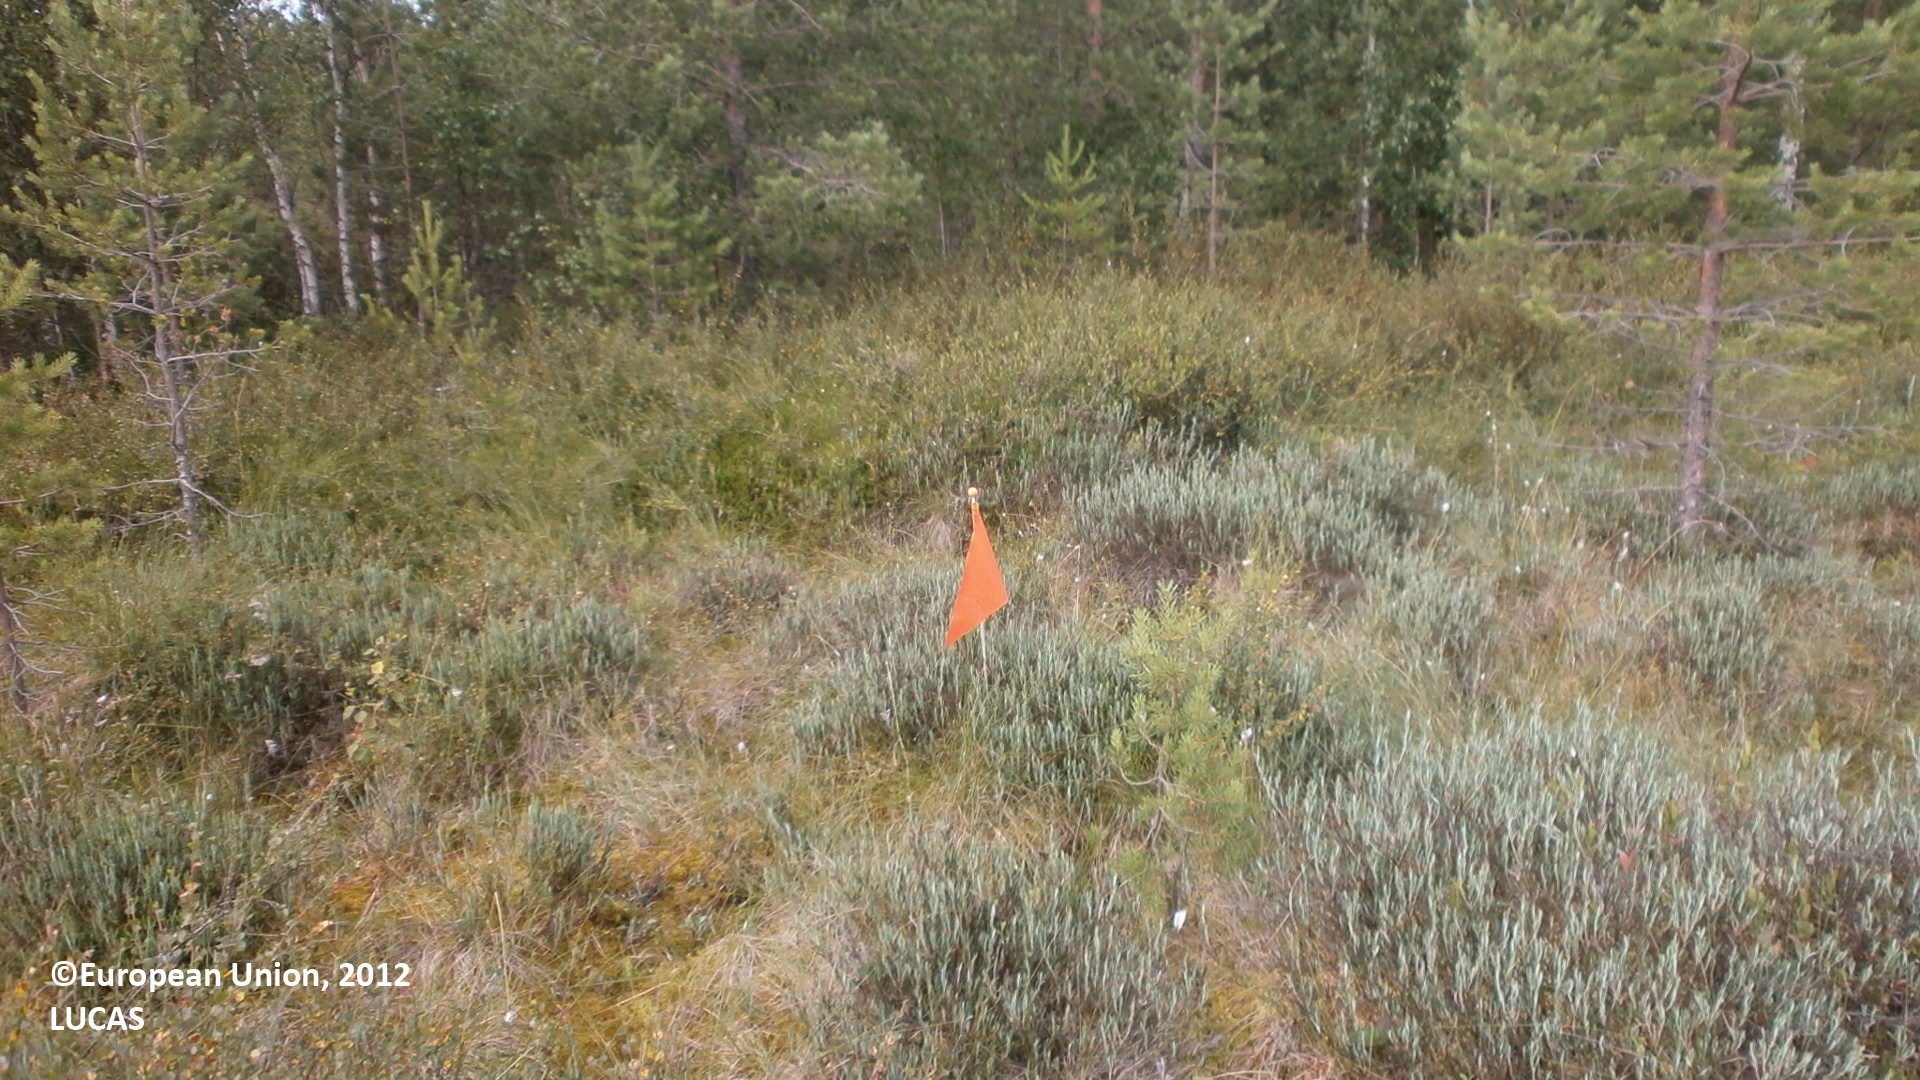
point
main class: Woodland
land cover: Pine dominated coniferous woodland
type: mire and swamp forests
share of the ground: 10 - 25 %
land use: Forestry
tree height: > 5 m
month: July
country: FI
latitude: 63.9526
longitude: 24.2564
